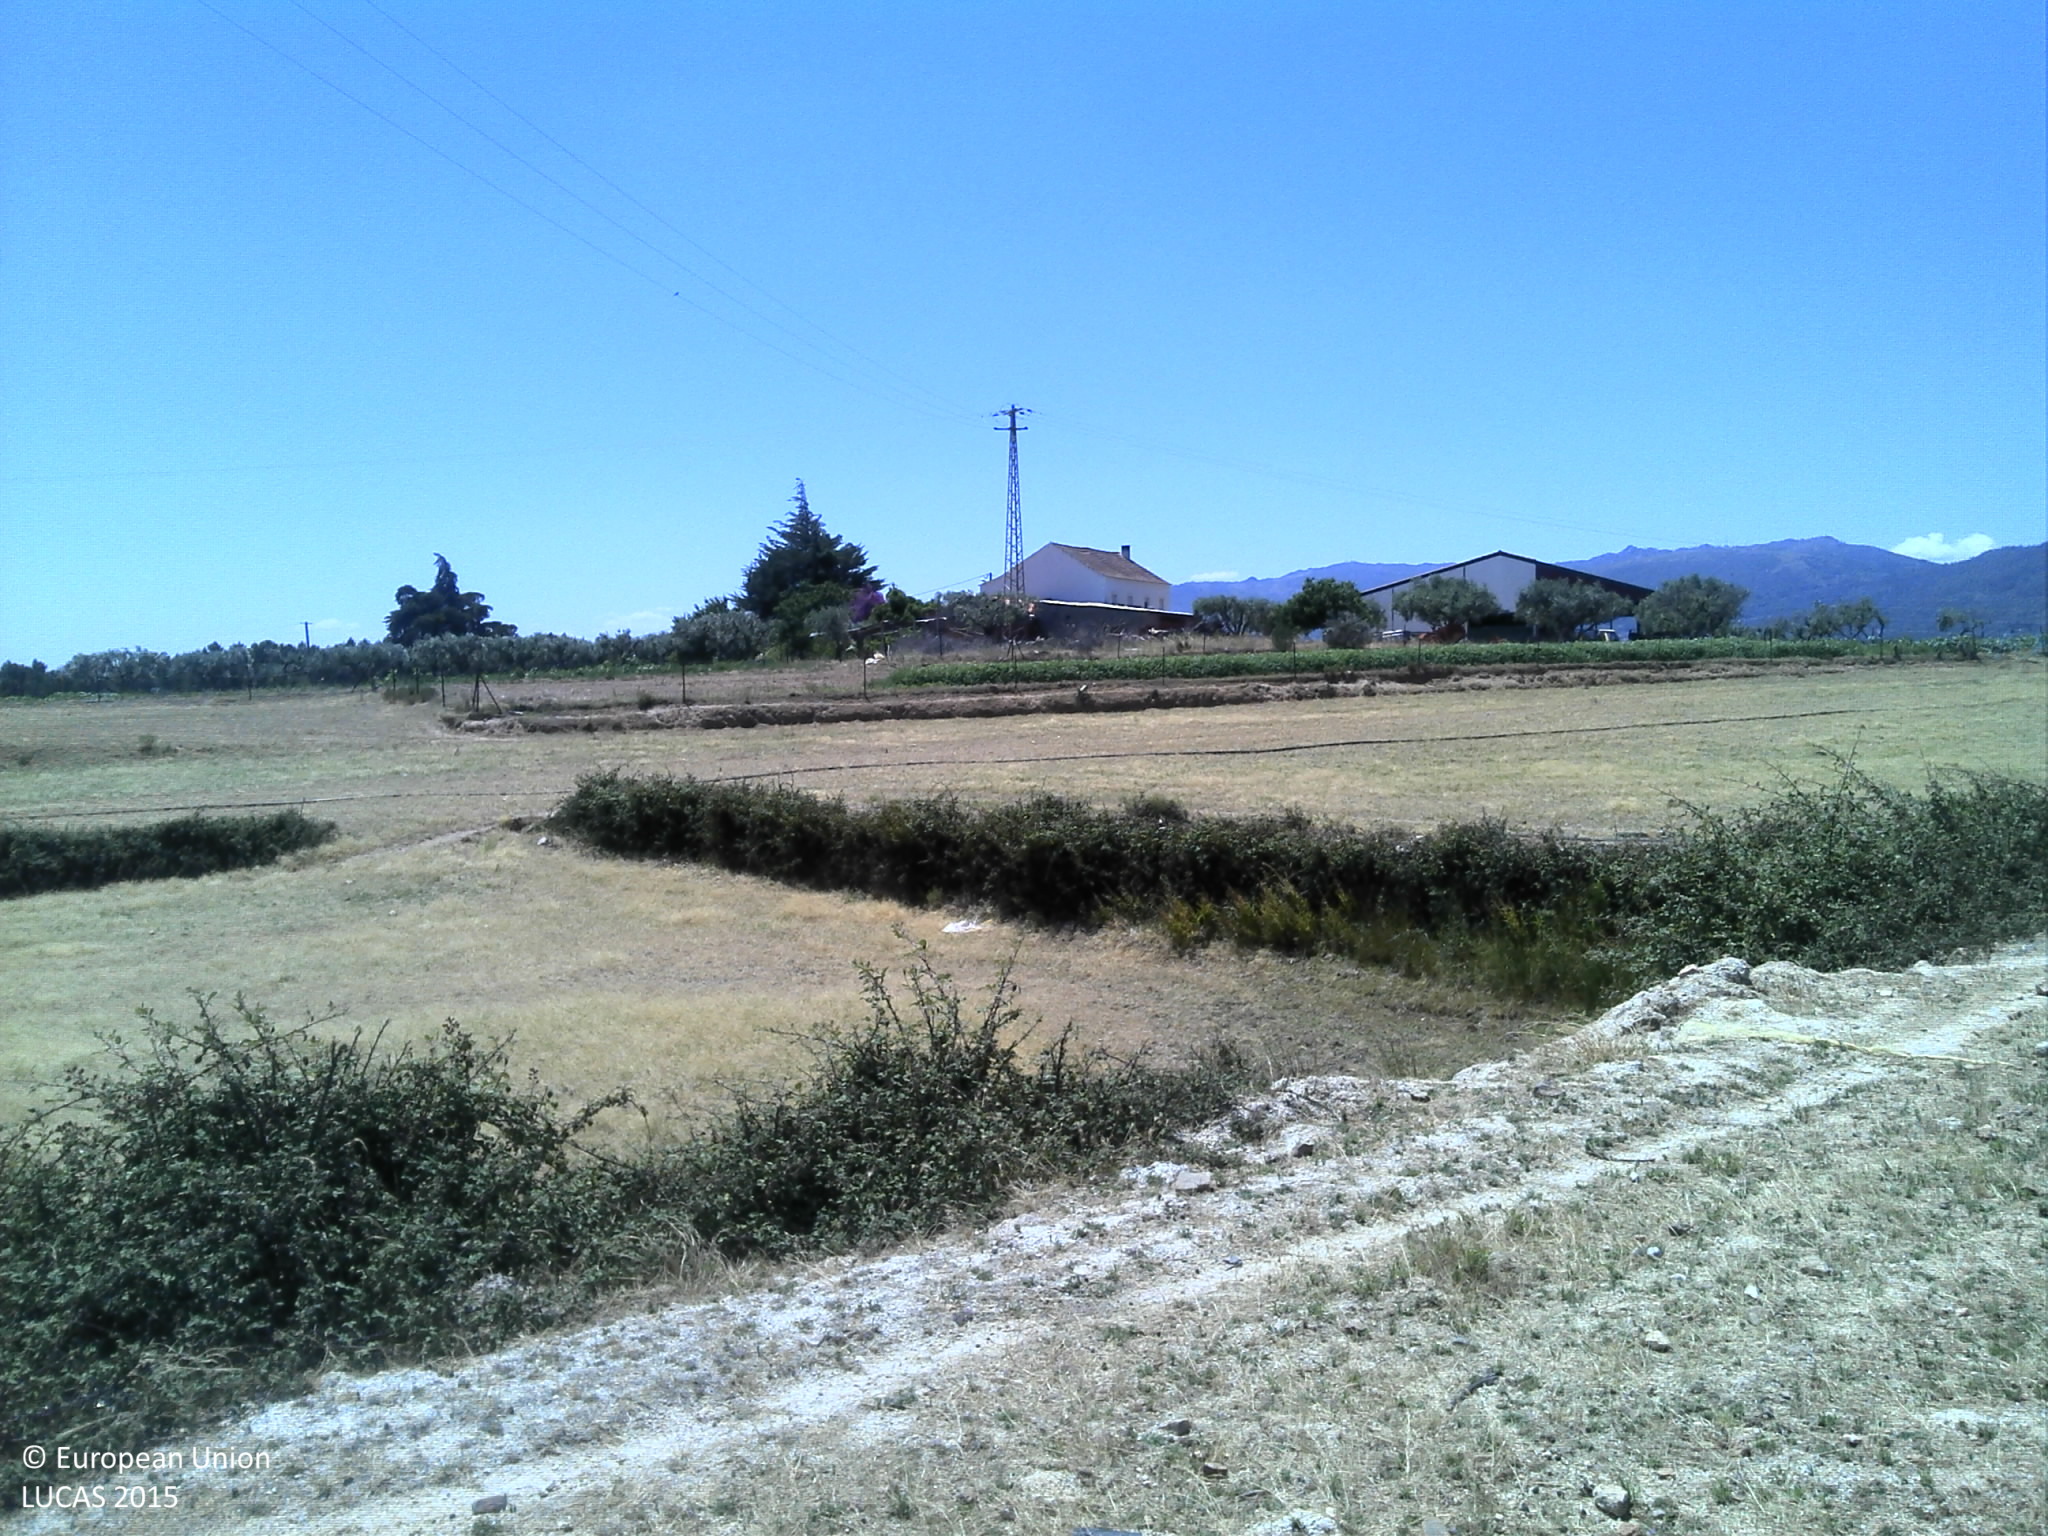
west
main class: Grassland
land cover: Grassland without tree/shrub cover
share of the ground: 25 - 50 %
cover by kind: unconsolidated bare surface 50 %, herbaceous plants 40 %
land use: Agriculture (excluding fallow land and kitchen gardens)
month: June
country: PT
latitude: 40.1049
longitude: -7.3814
